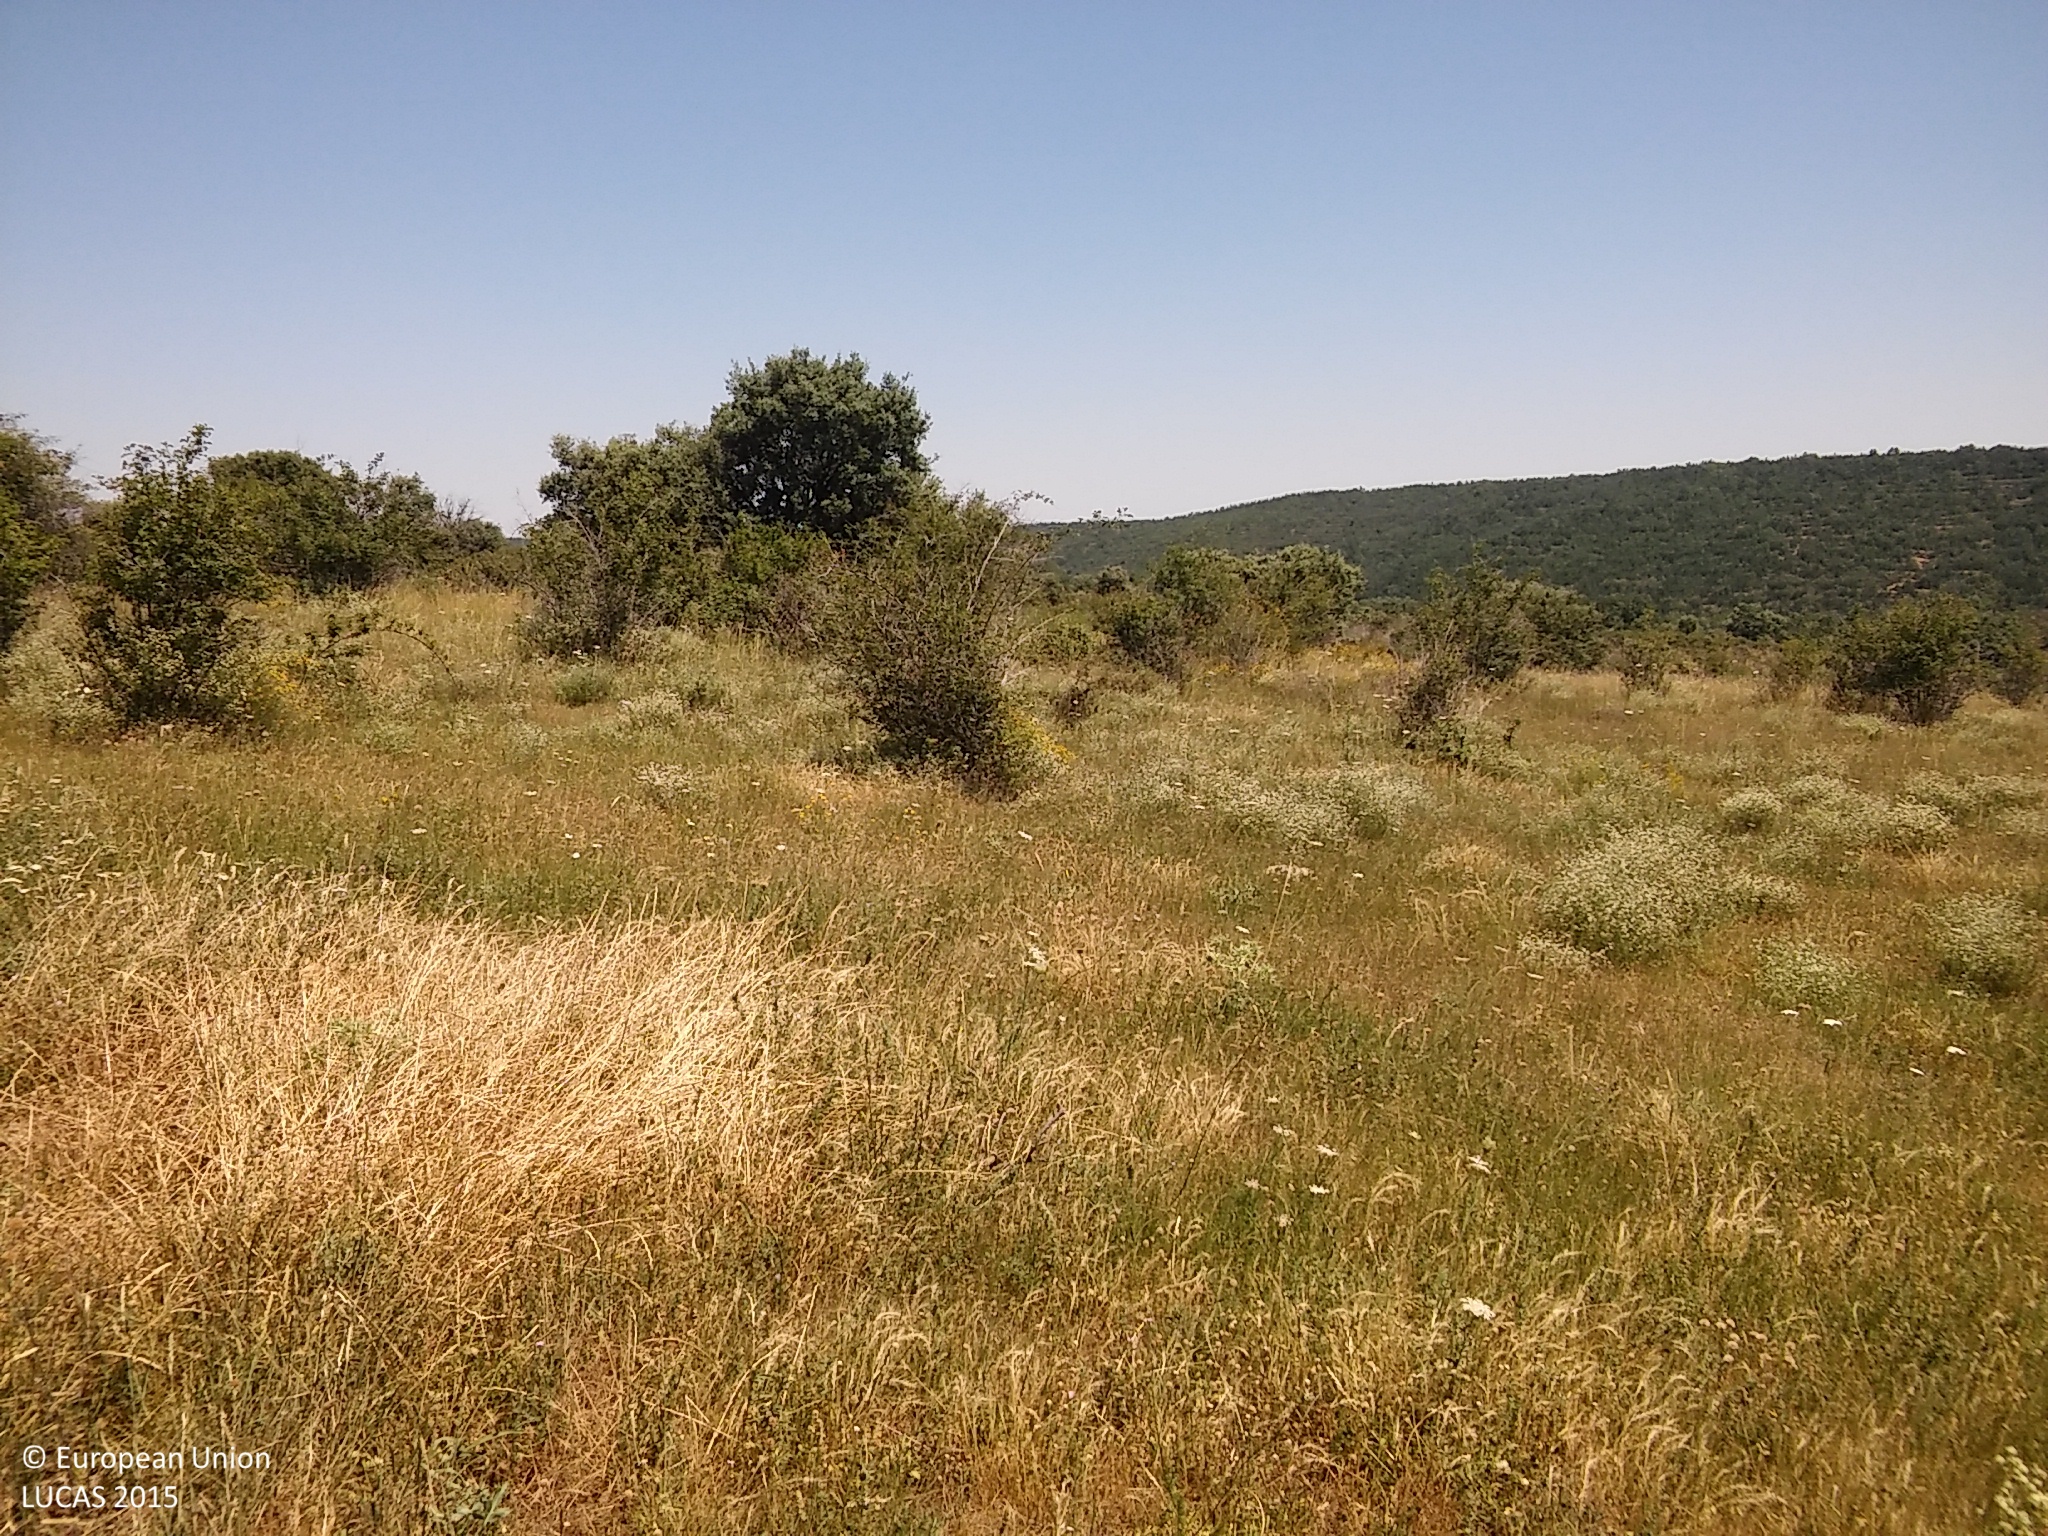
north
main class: Grassland
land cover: Grassland with sparse tree/shrub cover
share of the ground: > 75 %
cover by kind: herbaceous plants 90 %, broadleaved forest trees 5 %, shrubs 5 %
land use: Agriculture (excluding fallow land and kitchen gardens)
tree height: > 5 m
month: June
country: ES
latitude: 41.2460
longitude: -3.5419
